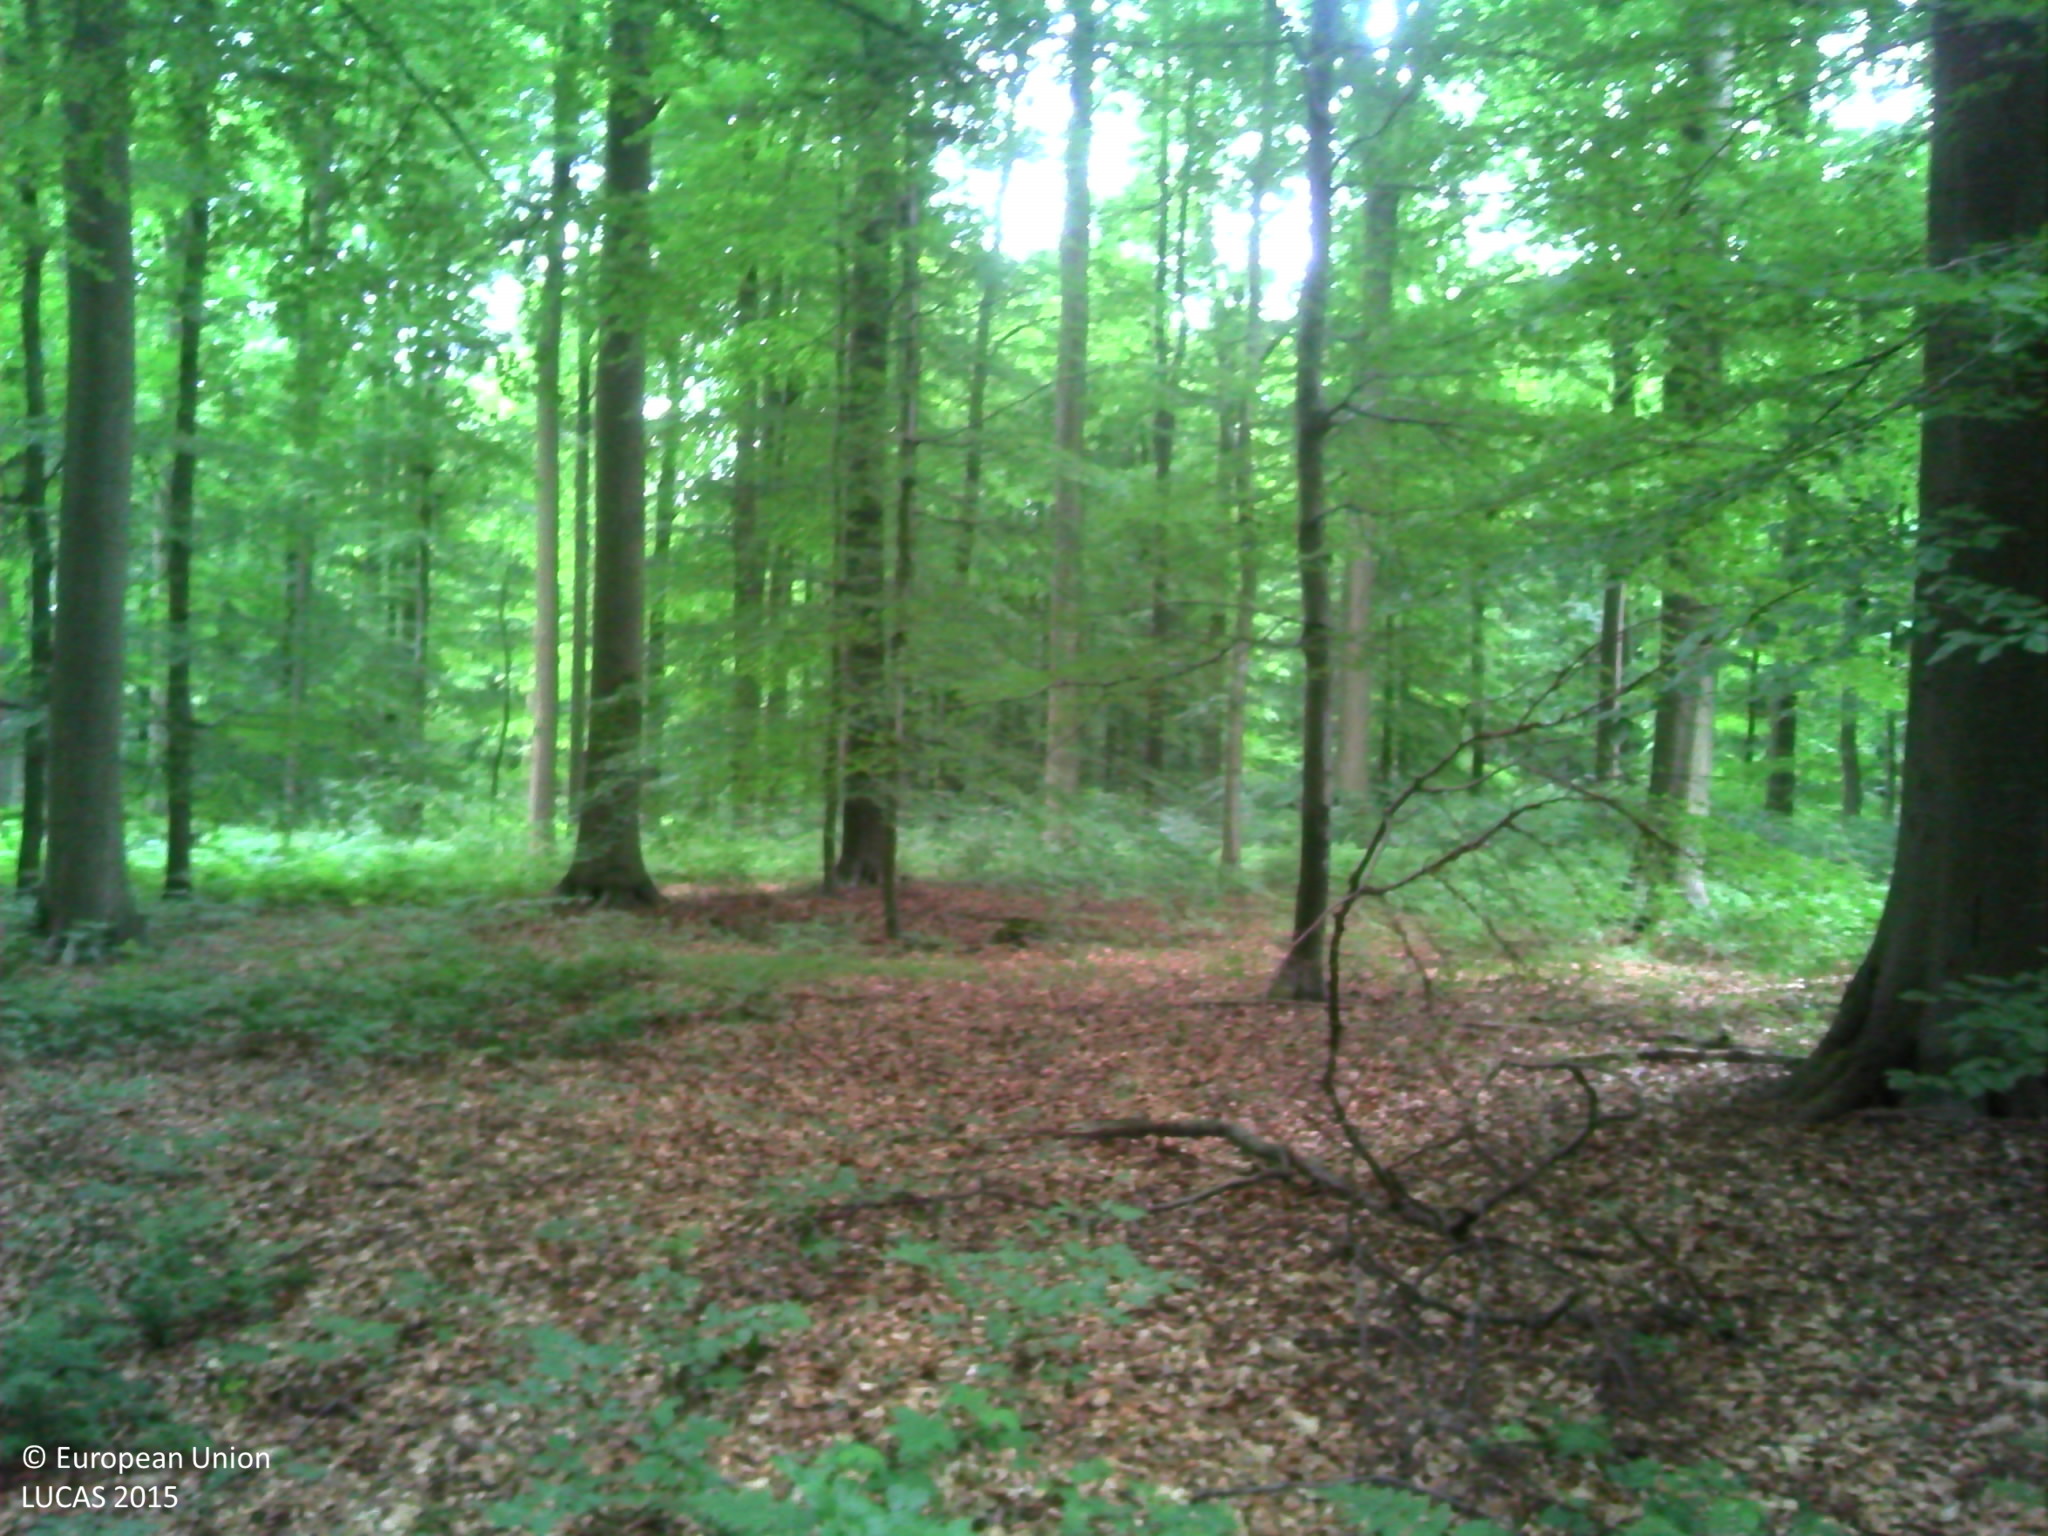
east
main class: Woodland
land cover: Broadleaved woodland
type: beech forest
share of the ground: > 75 %
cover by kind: broadleaved forest trees 90 %, herbaceous plants 5 %, lichens and mosses 5 %
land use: Forestry
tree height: > 5 m
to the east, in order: Broadleaved woodland; Tracks; Broadleaved woodland
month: July
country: BE
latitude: 50.7880
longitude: 4.4493
